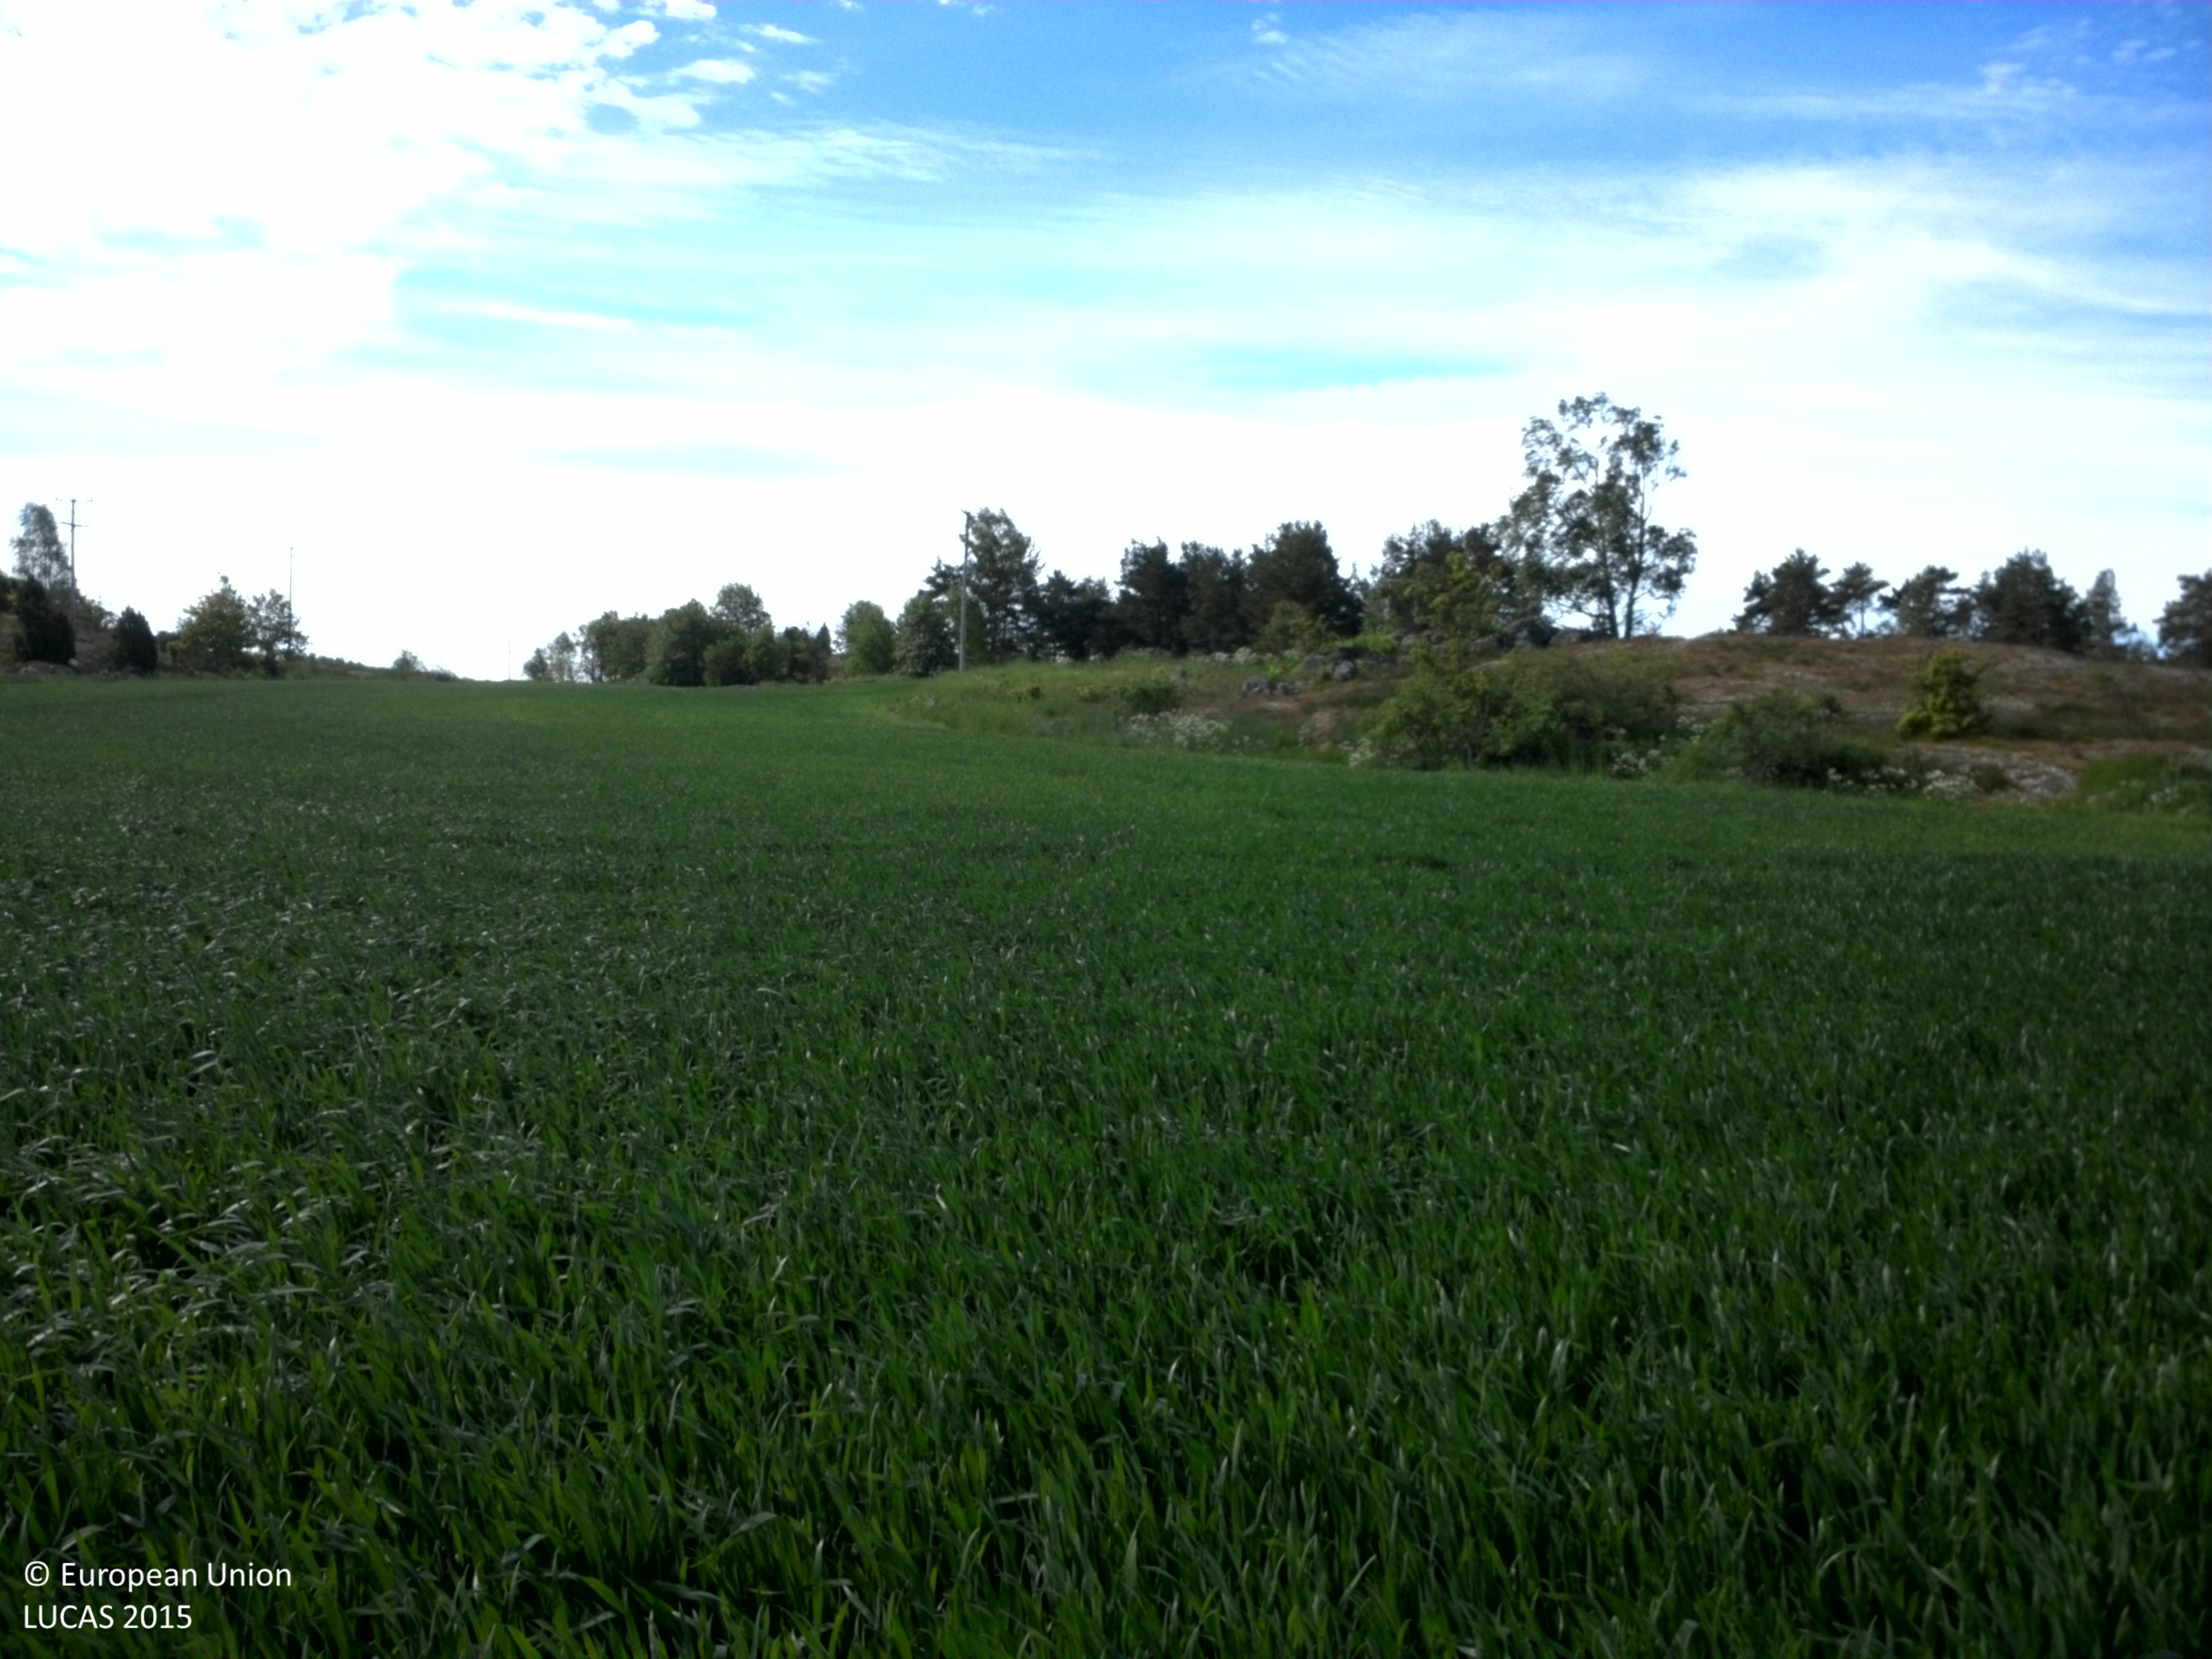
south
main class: Cropland
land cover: Barley
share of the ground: > 75 %
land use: Agriculture (excluding fallow land and kitchen gardens)
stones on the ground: < 10 %
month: June
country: SE
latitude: 58.4773
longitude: 15.7048
